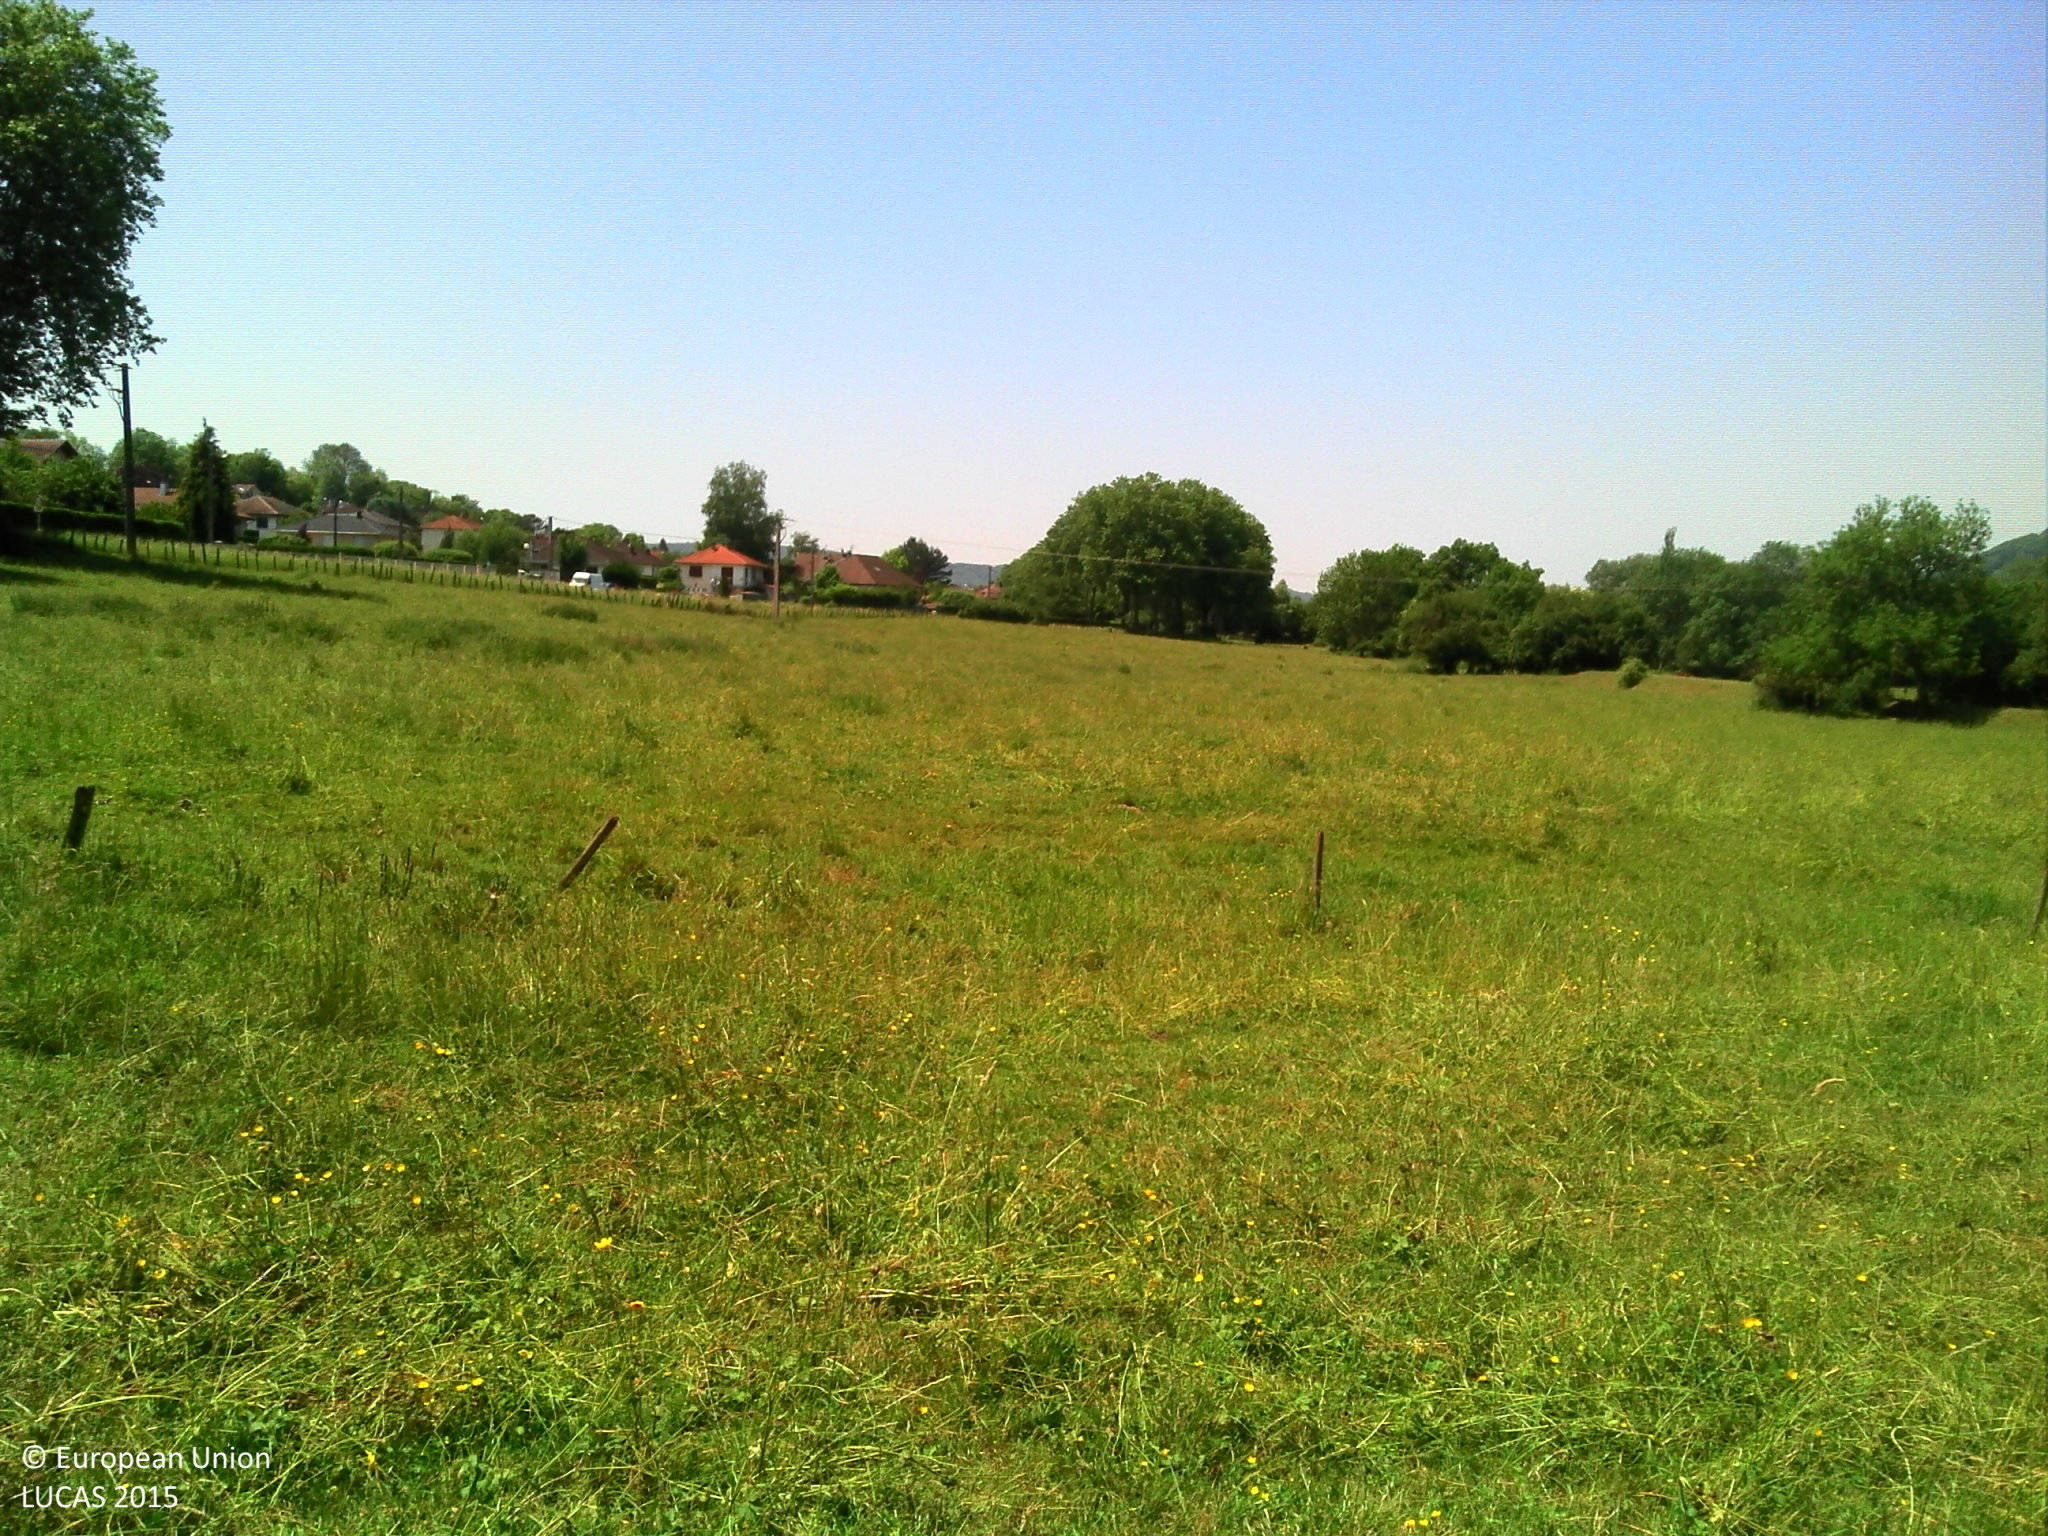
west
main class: Grassland
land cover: Grassland without tree/shrub cover
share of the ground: > 75 %
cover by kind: herbaceous plants 100 %
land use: Agriculture (excluding fallow land and kitchen gardens)
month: June
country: FR
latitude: 47.6170
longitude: 6.1828
